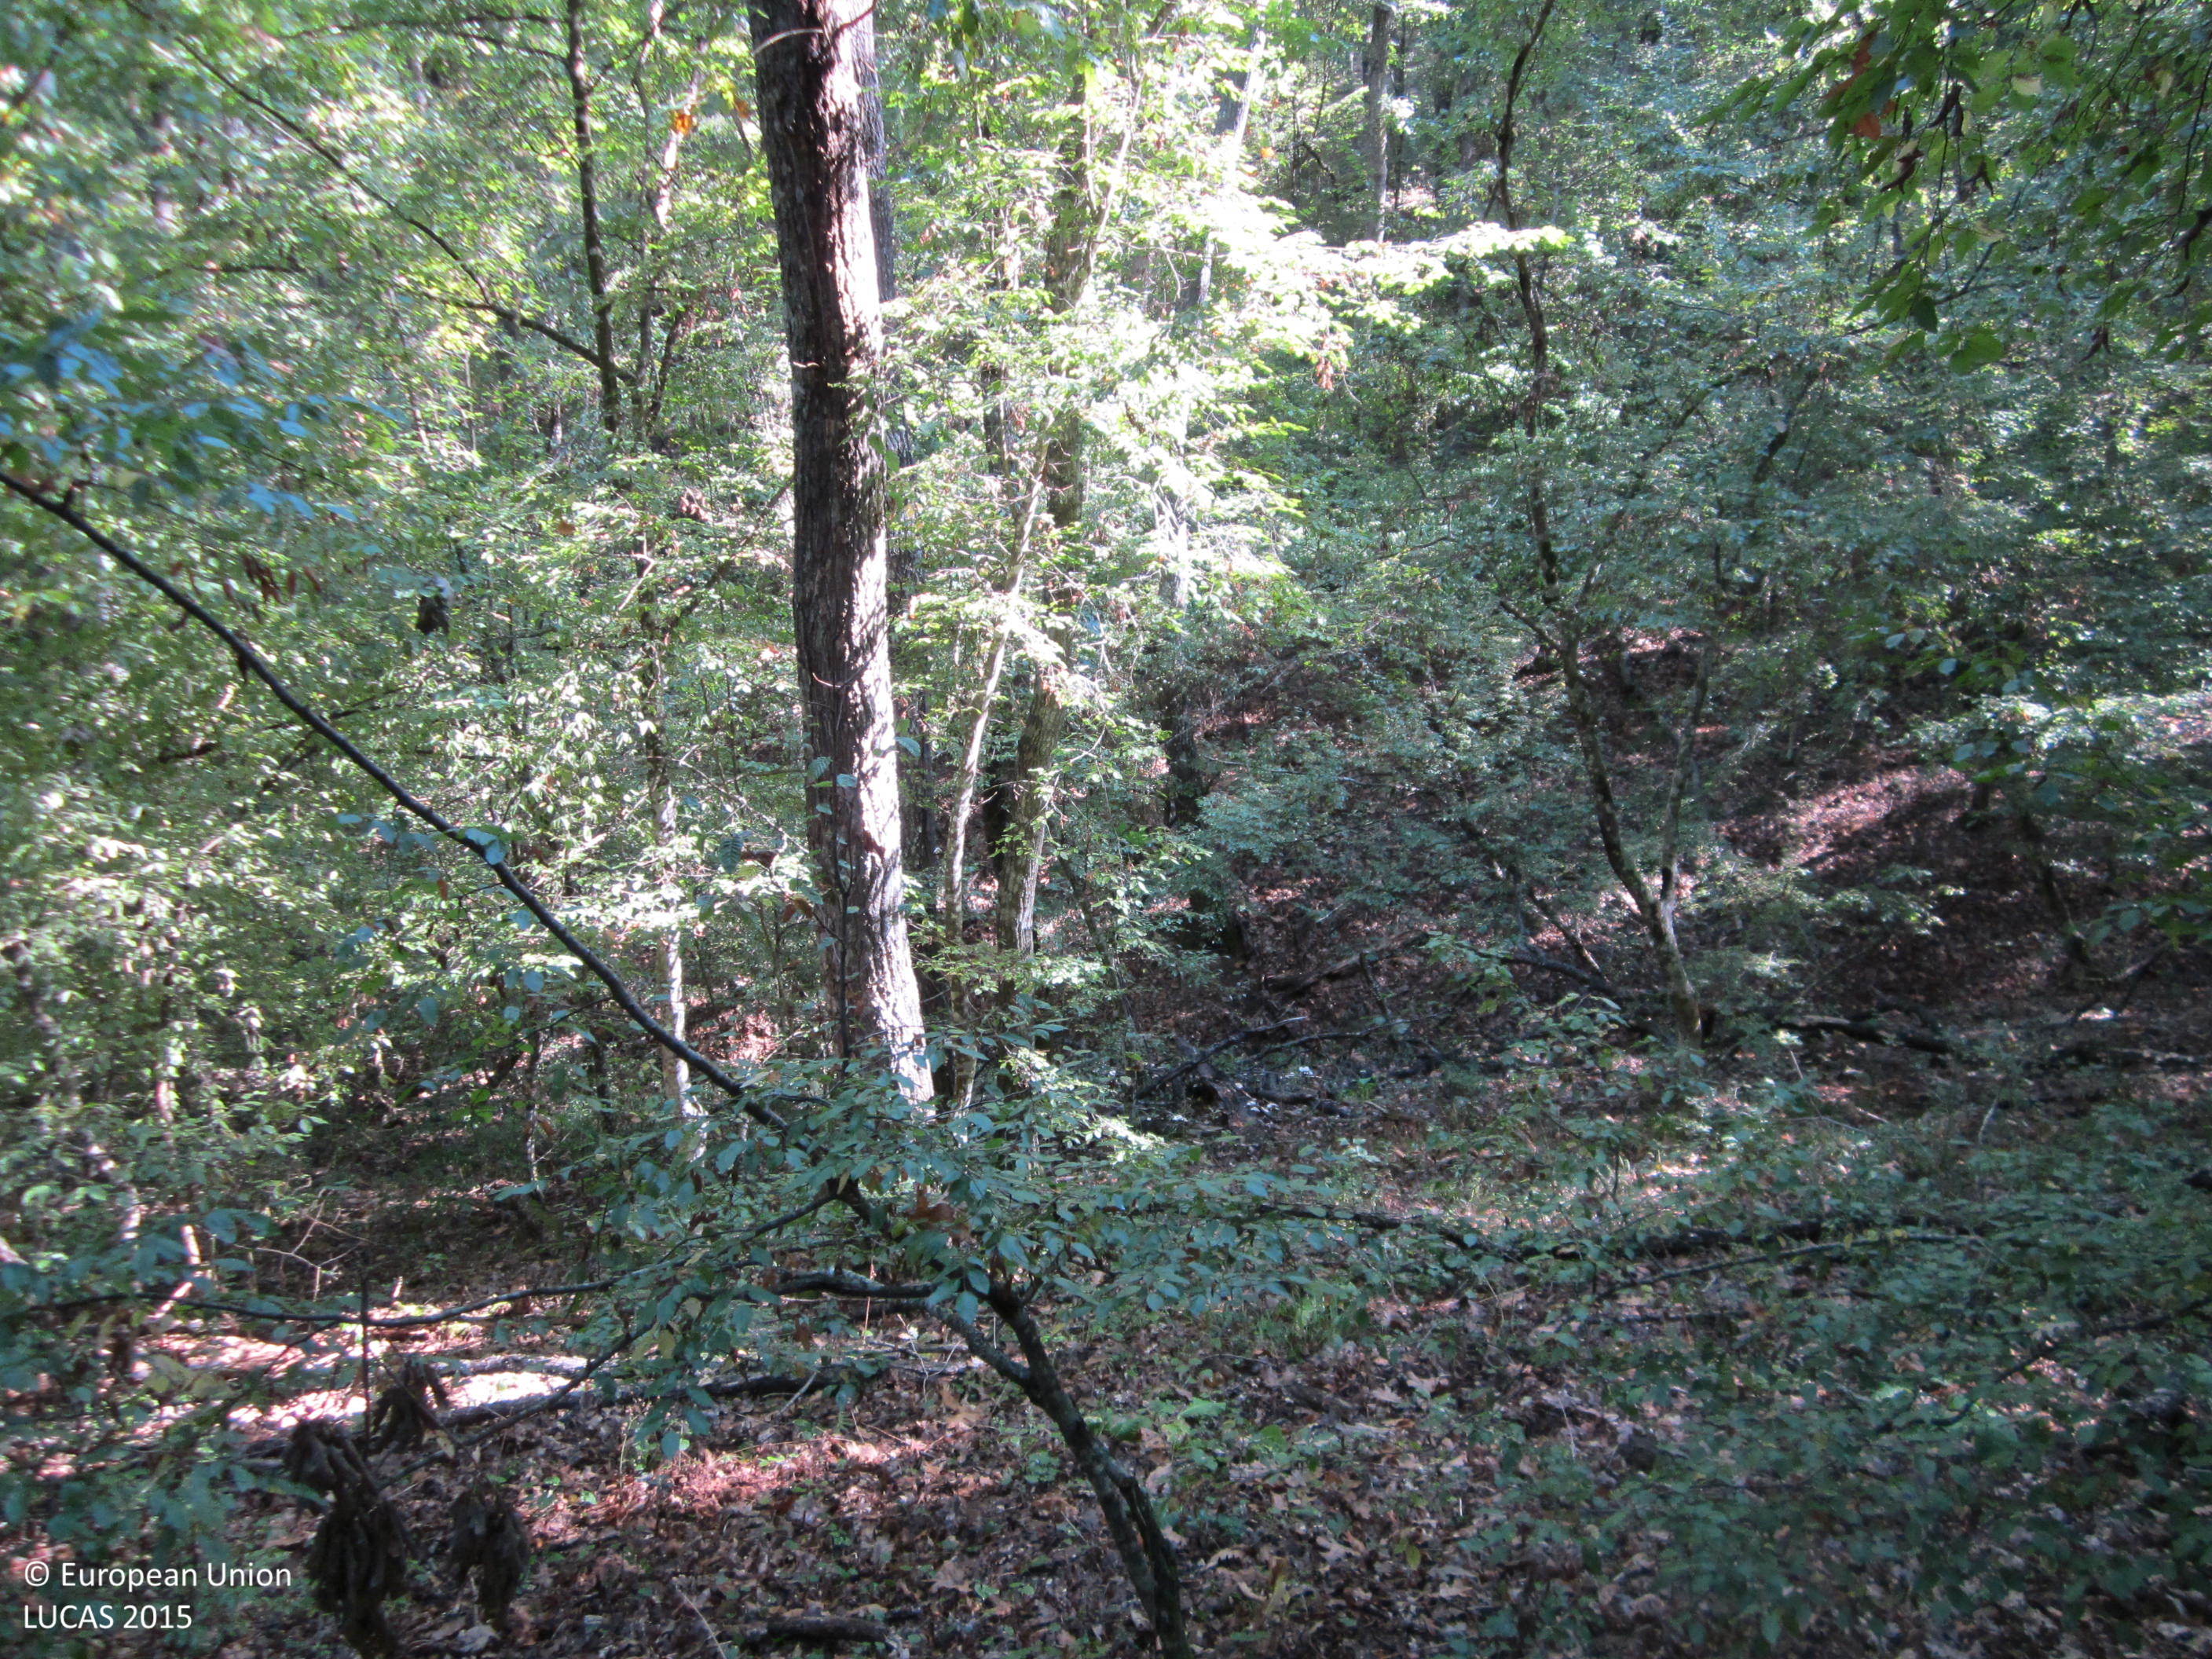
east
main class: Woodland
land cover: Broadleaved woodland
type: thermophilous deciduous forest
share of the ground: > 75 %
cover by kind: broadleaved forest trees 100 %
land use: Forestry
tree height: > 5 m
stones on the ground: < 10 %
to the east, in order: Broadleaved woodland; Rivers and streams; Broadleaved woodland; Tracks; Broadleaved woodland
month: September
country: BG
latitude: 42.2198
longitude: 27.1996
